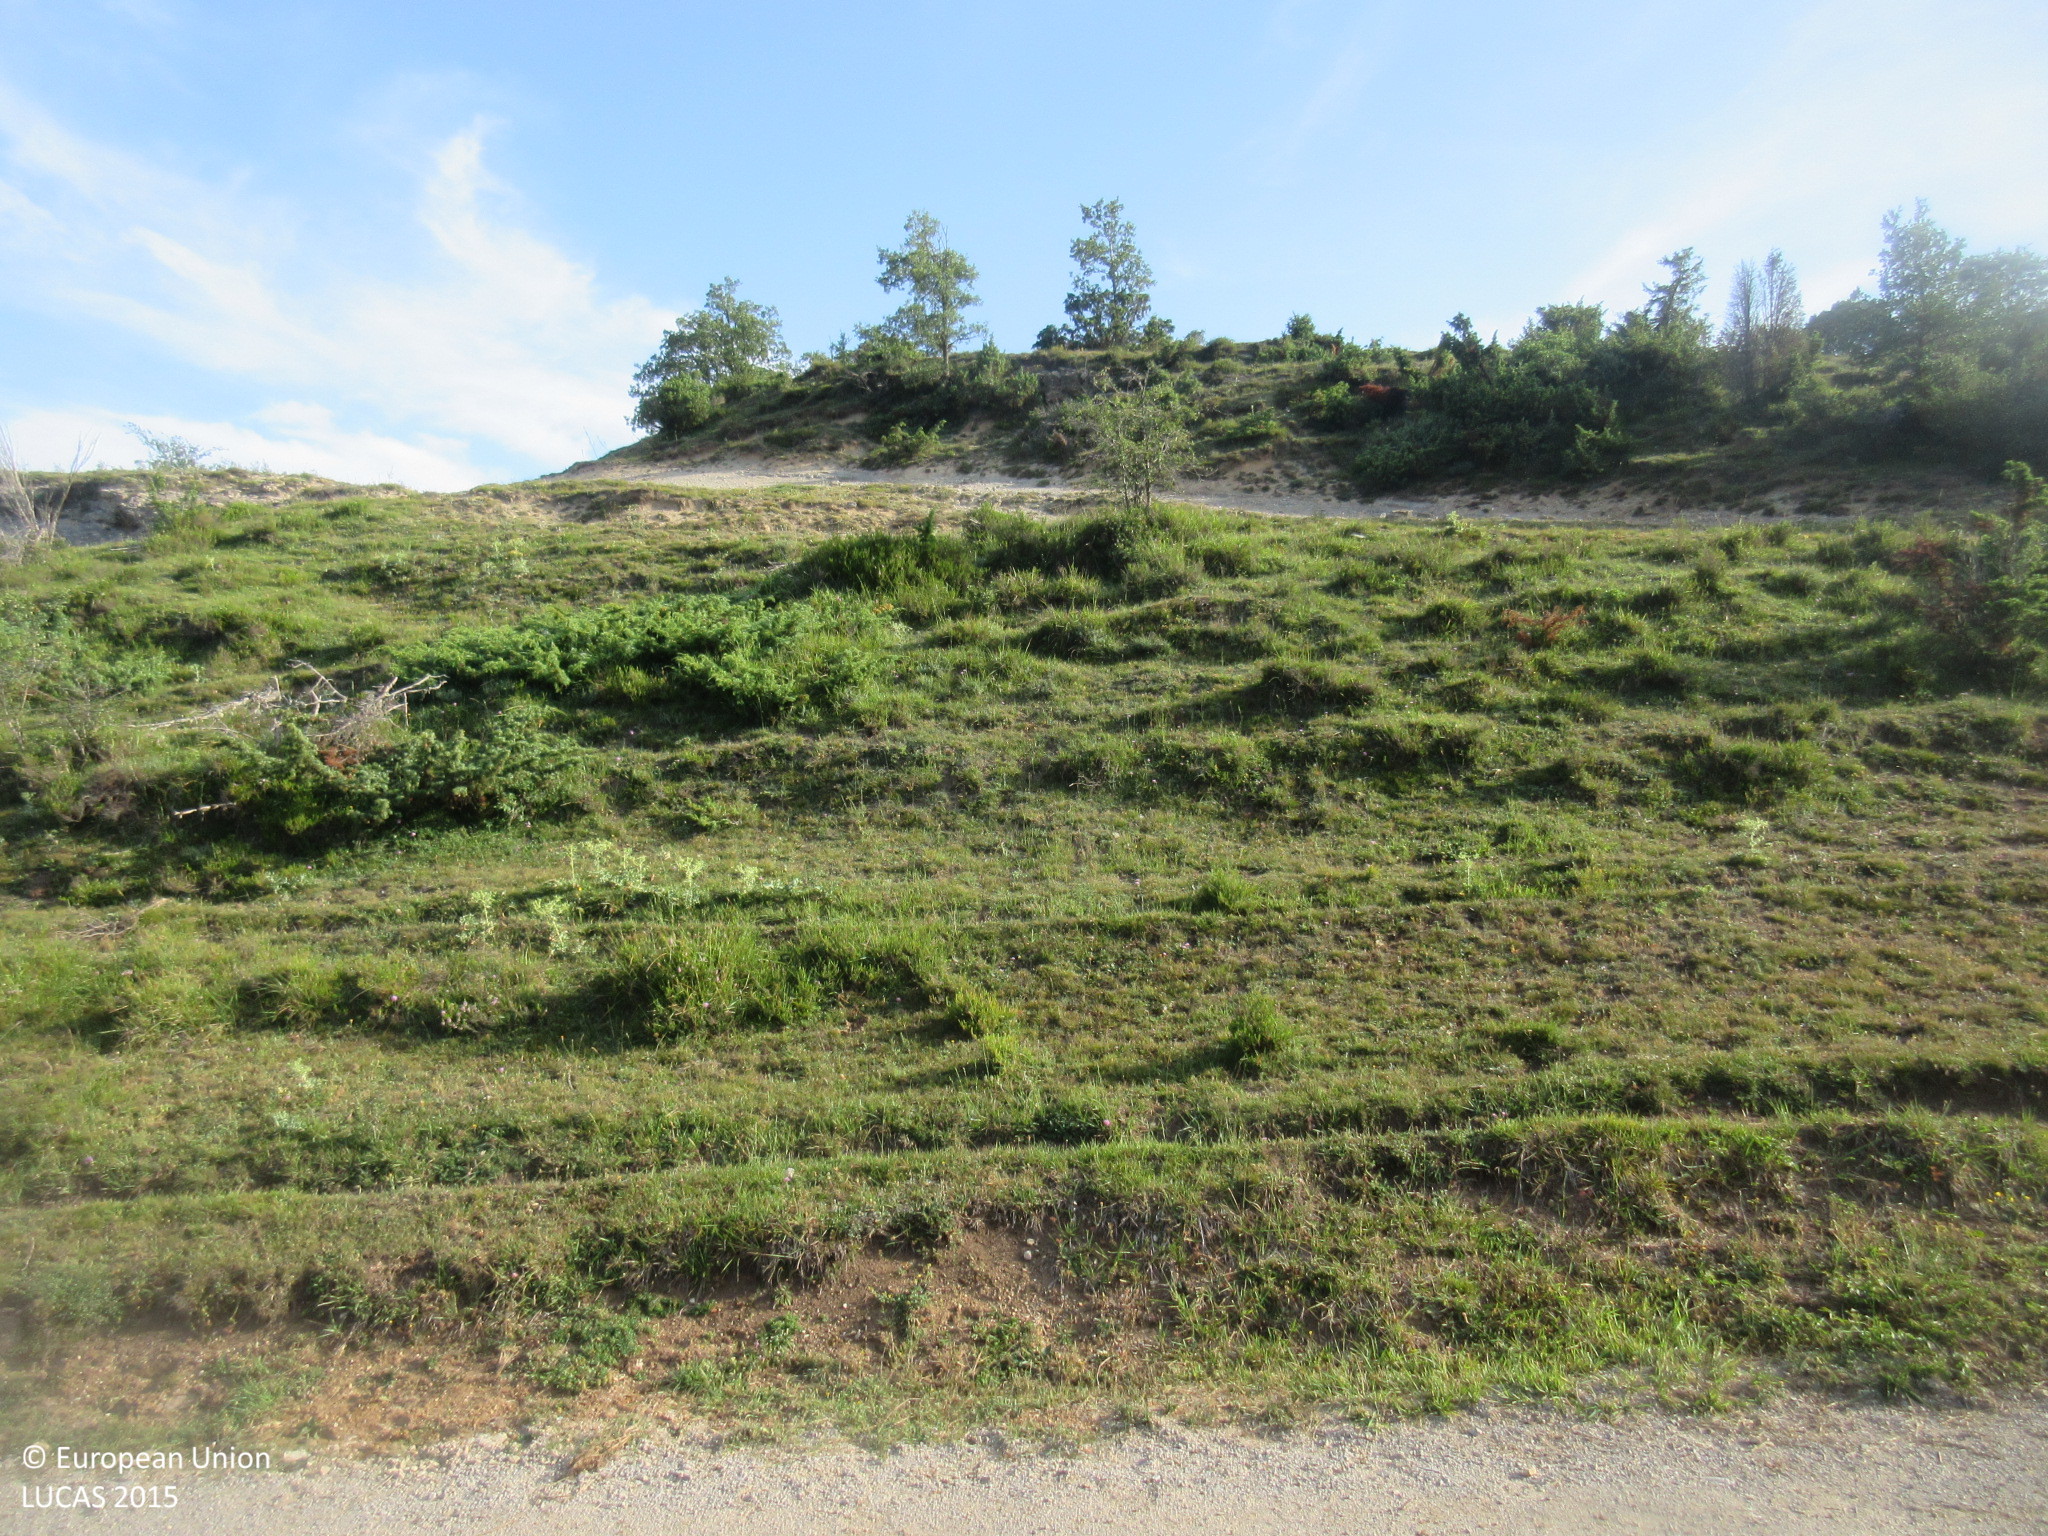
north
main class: Woodland
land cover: Broadleaved woodland
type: thermophilous deciduous forest
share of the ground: > 75 %
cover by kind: broadleaved forest trees 80 %, herbaceous plants 20 %
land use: Agriculture (excluding fallow land and kitchen gardens)
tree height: > 5 m
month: July
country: ES
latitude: 43.0587
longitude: -3.3854
